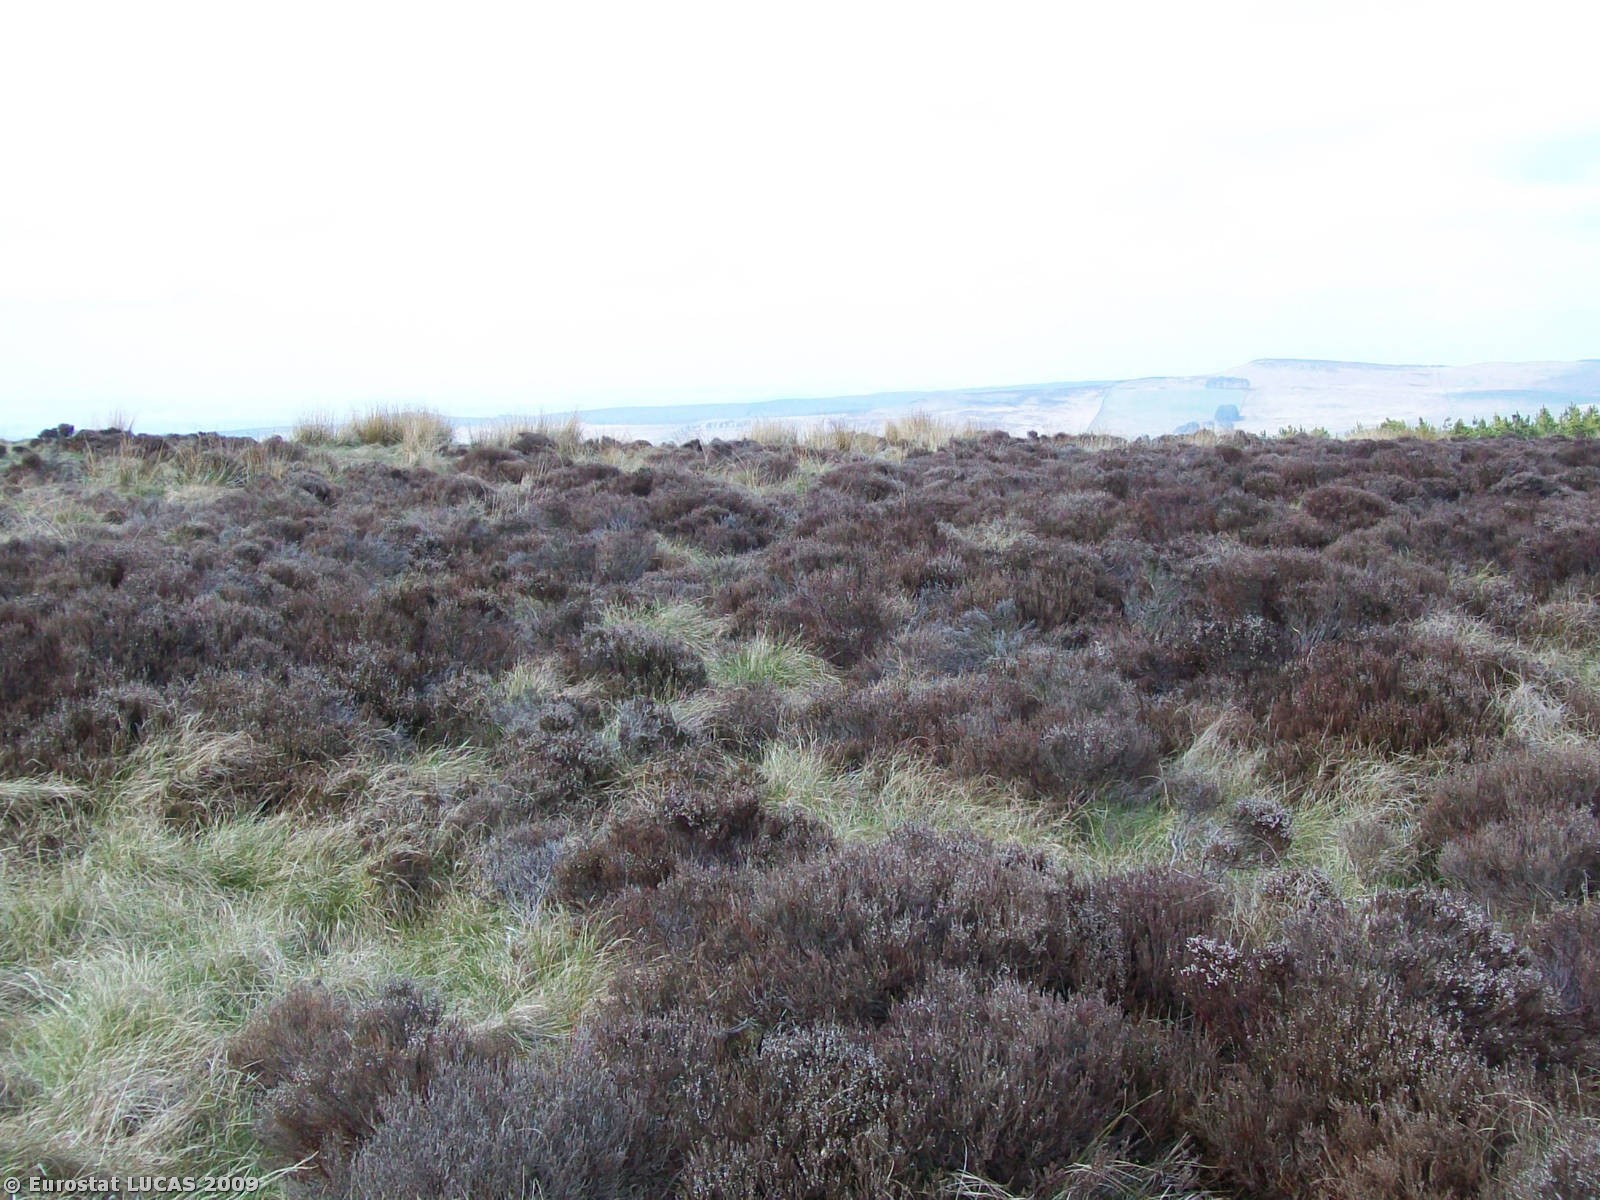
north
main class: Shrubland
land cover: Shrubland without tree cover
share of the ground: > 75 %
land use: Agriculture (excluding fallow land and kitchen gardens)
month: April
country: GB
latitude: 55.1552
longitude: -2.1245
